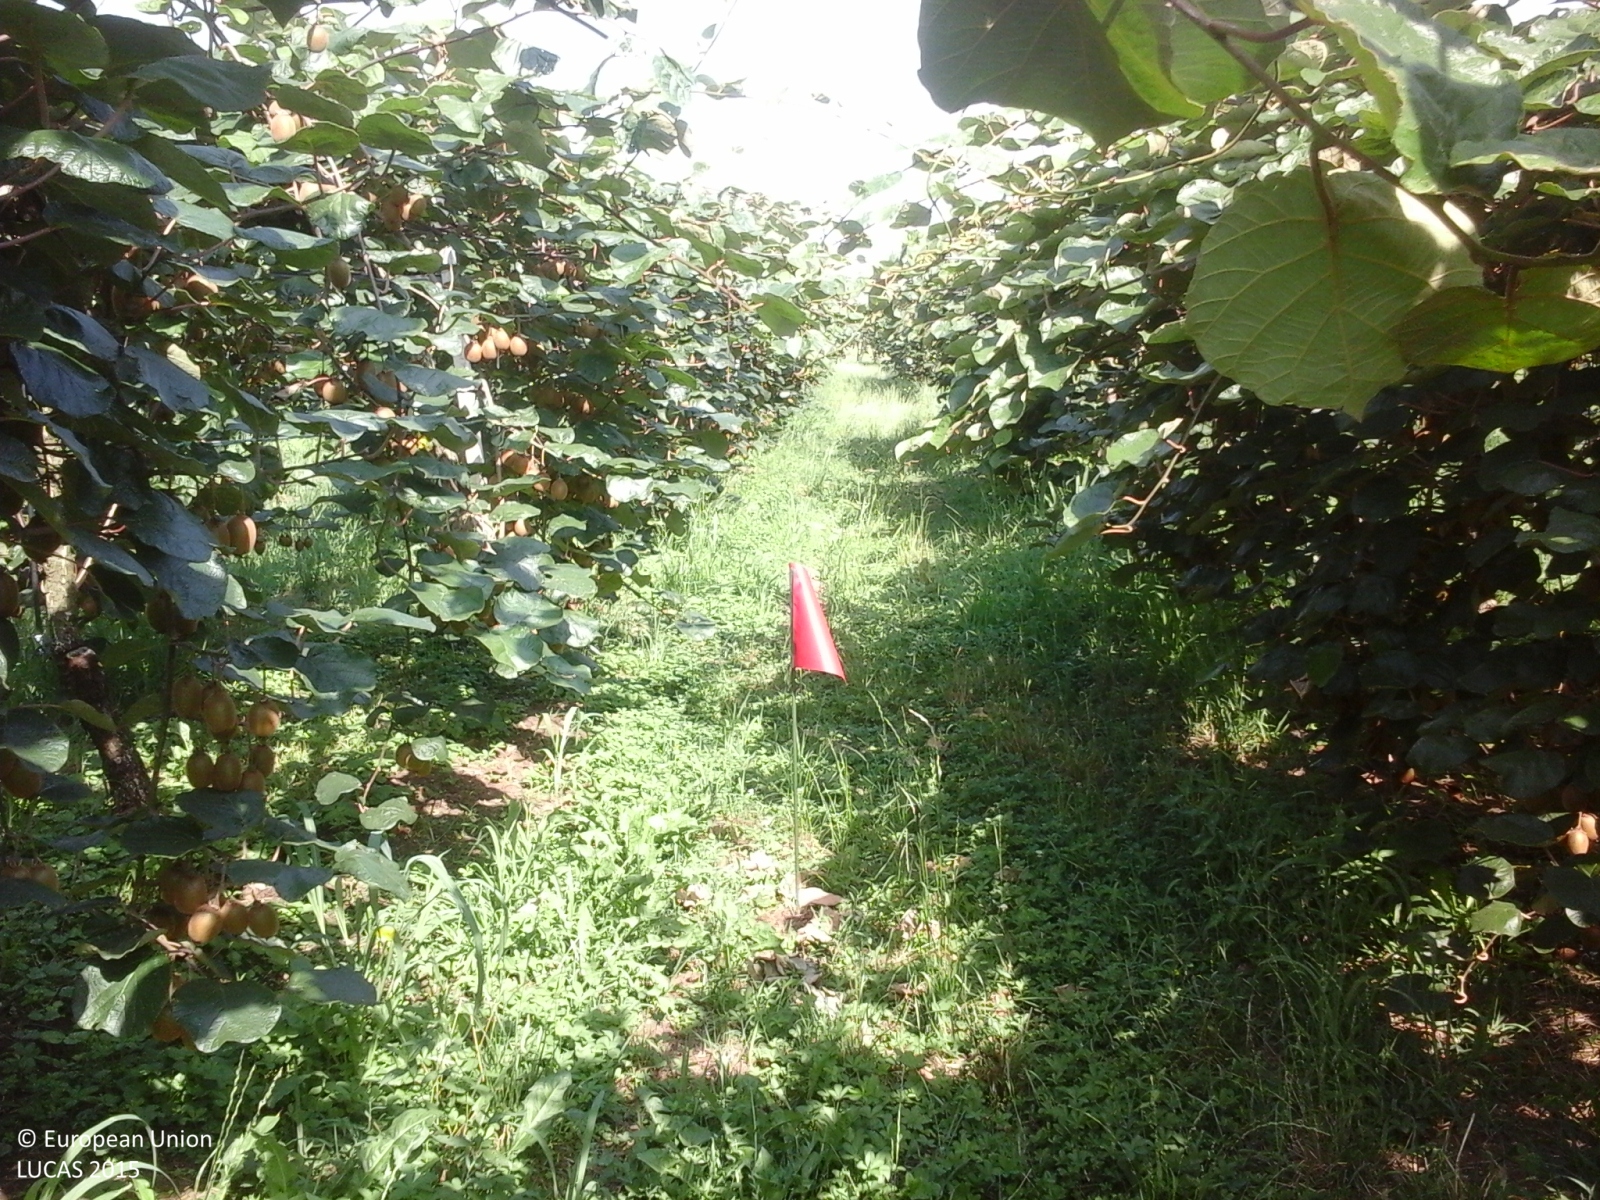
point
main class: Cropland
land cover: Other fruit trees and berries
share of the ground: > 75 %
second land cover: Grassland without tree/shrub cover
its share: > 75 %
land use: Agriculture (excluding fallow land and kitchen gardens)
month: July
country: IT
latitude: 45.3211
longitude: 10.8023
